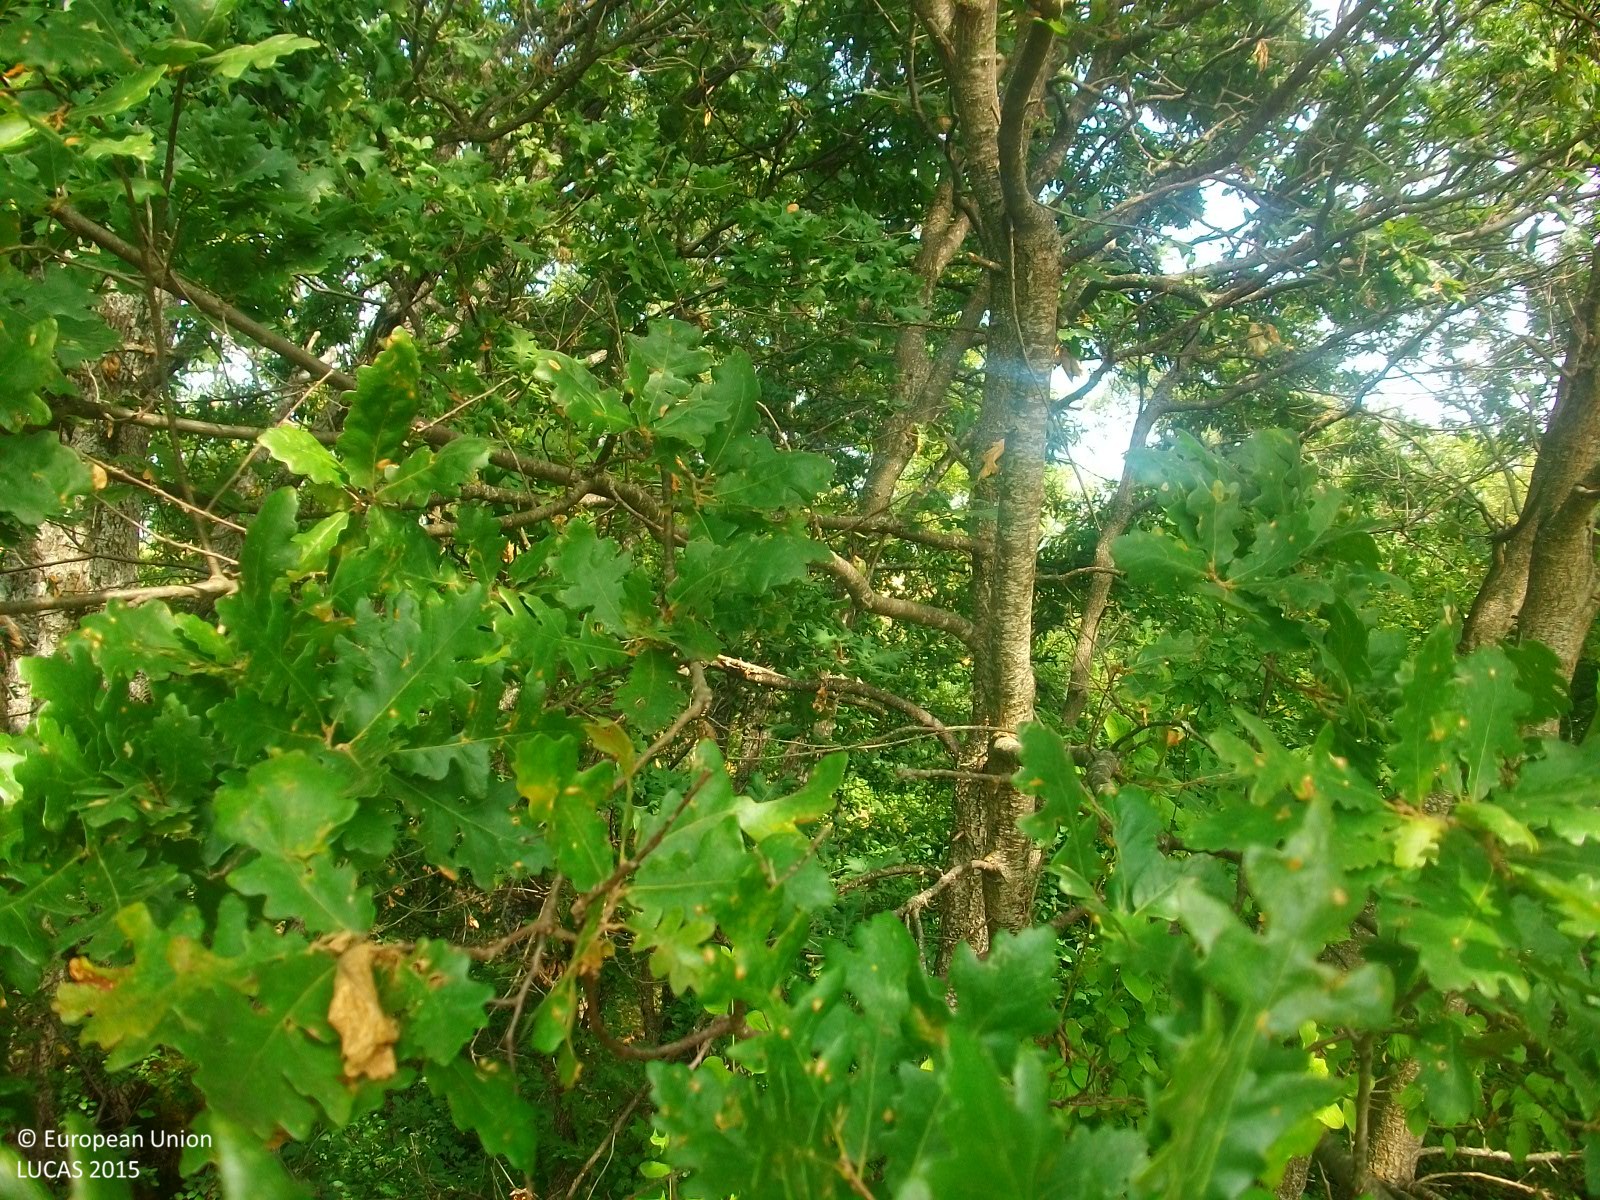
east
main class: Woodland
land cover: Broadleaved woodland
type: thermophilous deciduous forest
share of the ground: > 75 %
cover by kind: broadleaved forest trees 90 %, shrubs 10 %
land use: Semi-natural and natural areas not in use
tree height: > 5 m
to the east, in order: Broadleaved woodland; Durum wheat; Tracks; Broadleaved woodland; Grass margins; Tracks; Sunflower
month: August
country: GR
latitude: 41.3022
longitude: 26.2047
